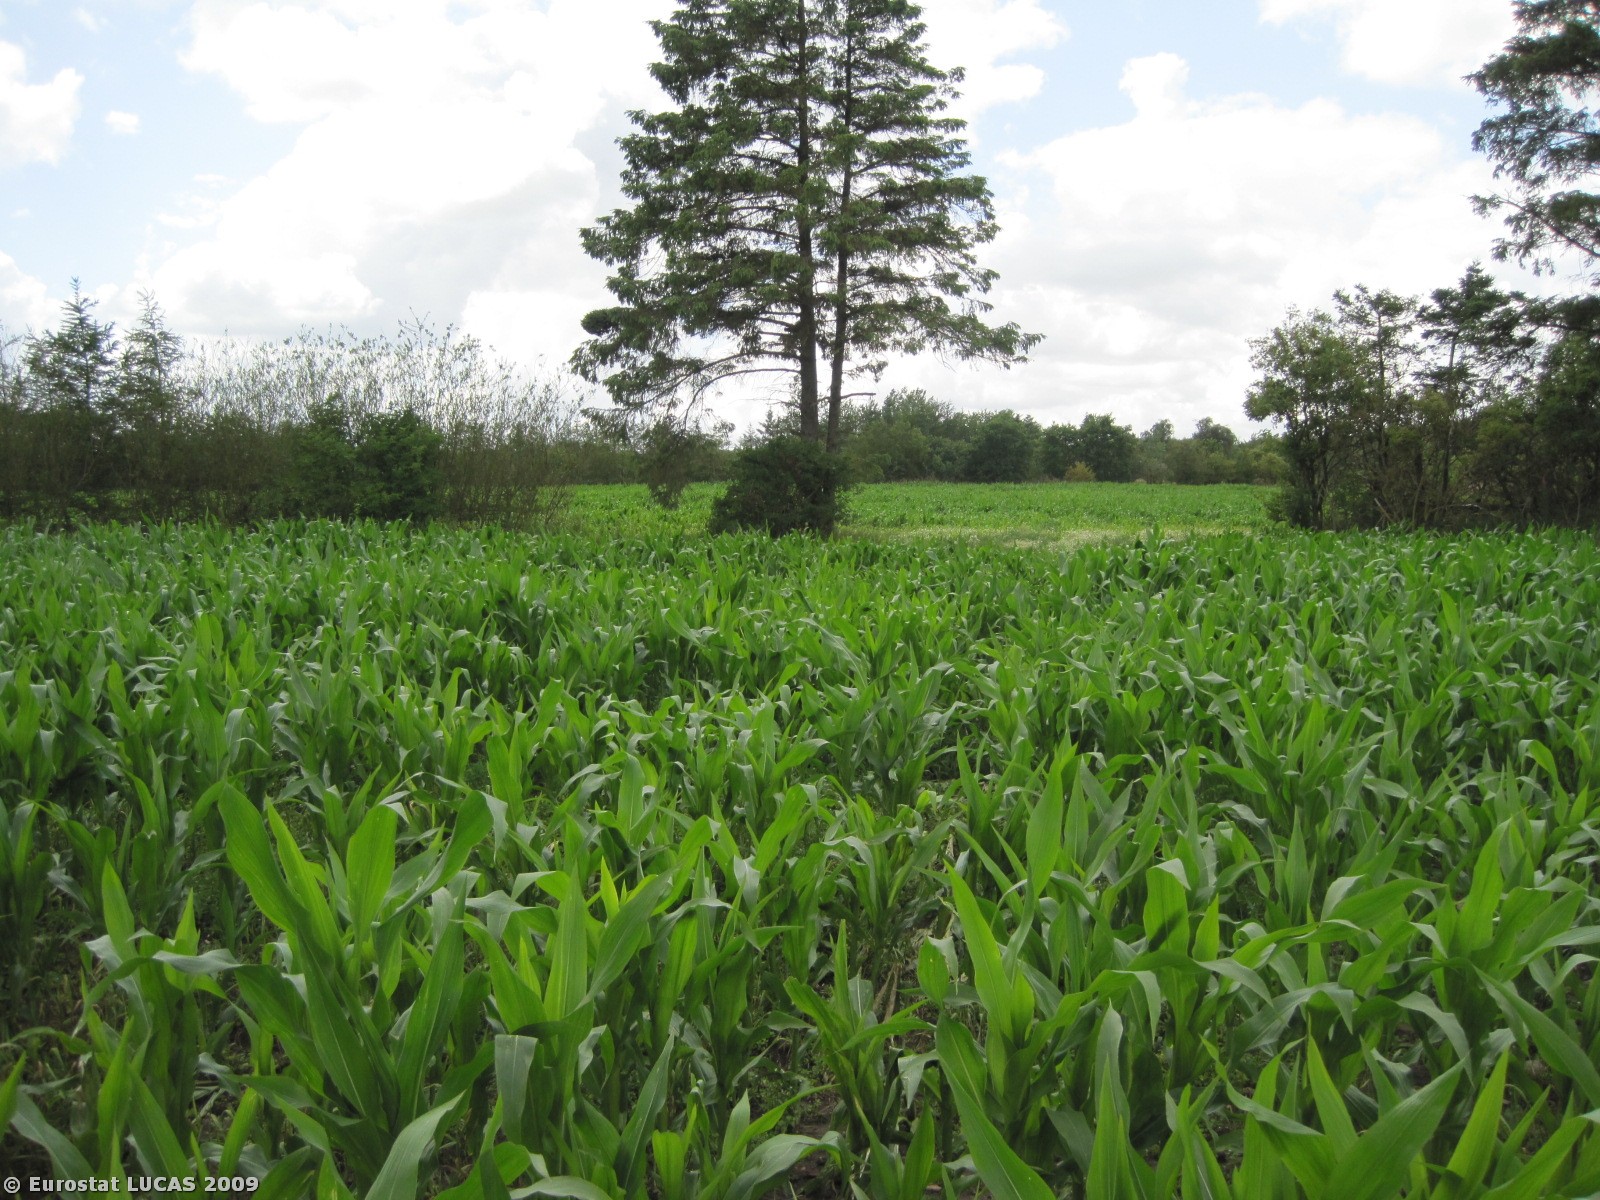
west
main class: Cropland
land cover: Maize
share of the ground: 25 - 50 %
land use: Agriculture (excluding fallow land and kitchen gardens)
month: July
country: DK
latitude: 56.4354
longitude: 8.9796
